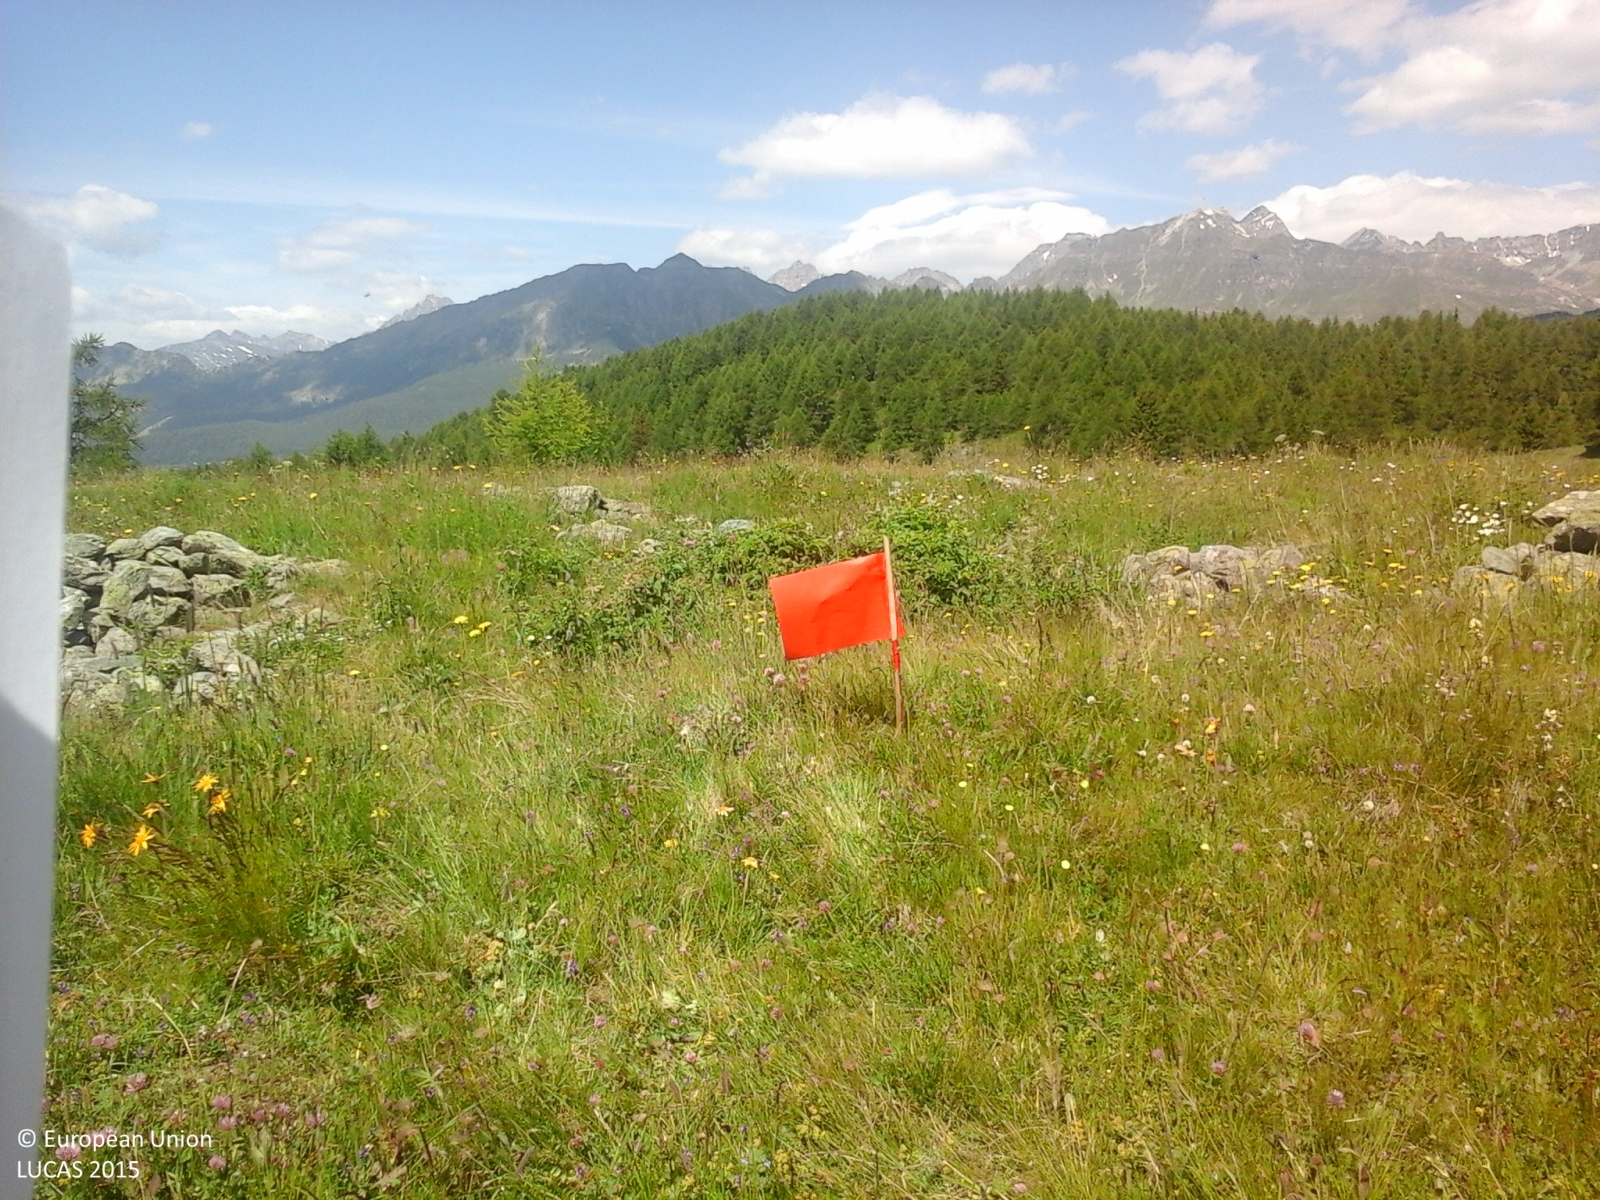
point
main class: Grassland
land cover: Grassland with sparse tree/shrub cover
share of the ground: > 75 %
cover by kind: herbaceous plants 90 %, coniferous forest trees 5 %
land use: Agriculture (excluding fallow land and kitchen gardens)
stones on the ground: < 10 %
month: June
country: IT
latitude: 45.8202
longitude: 7.6222
